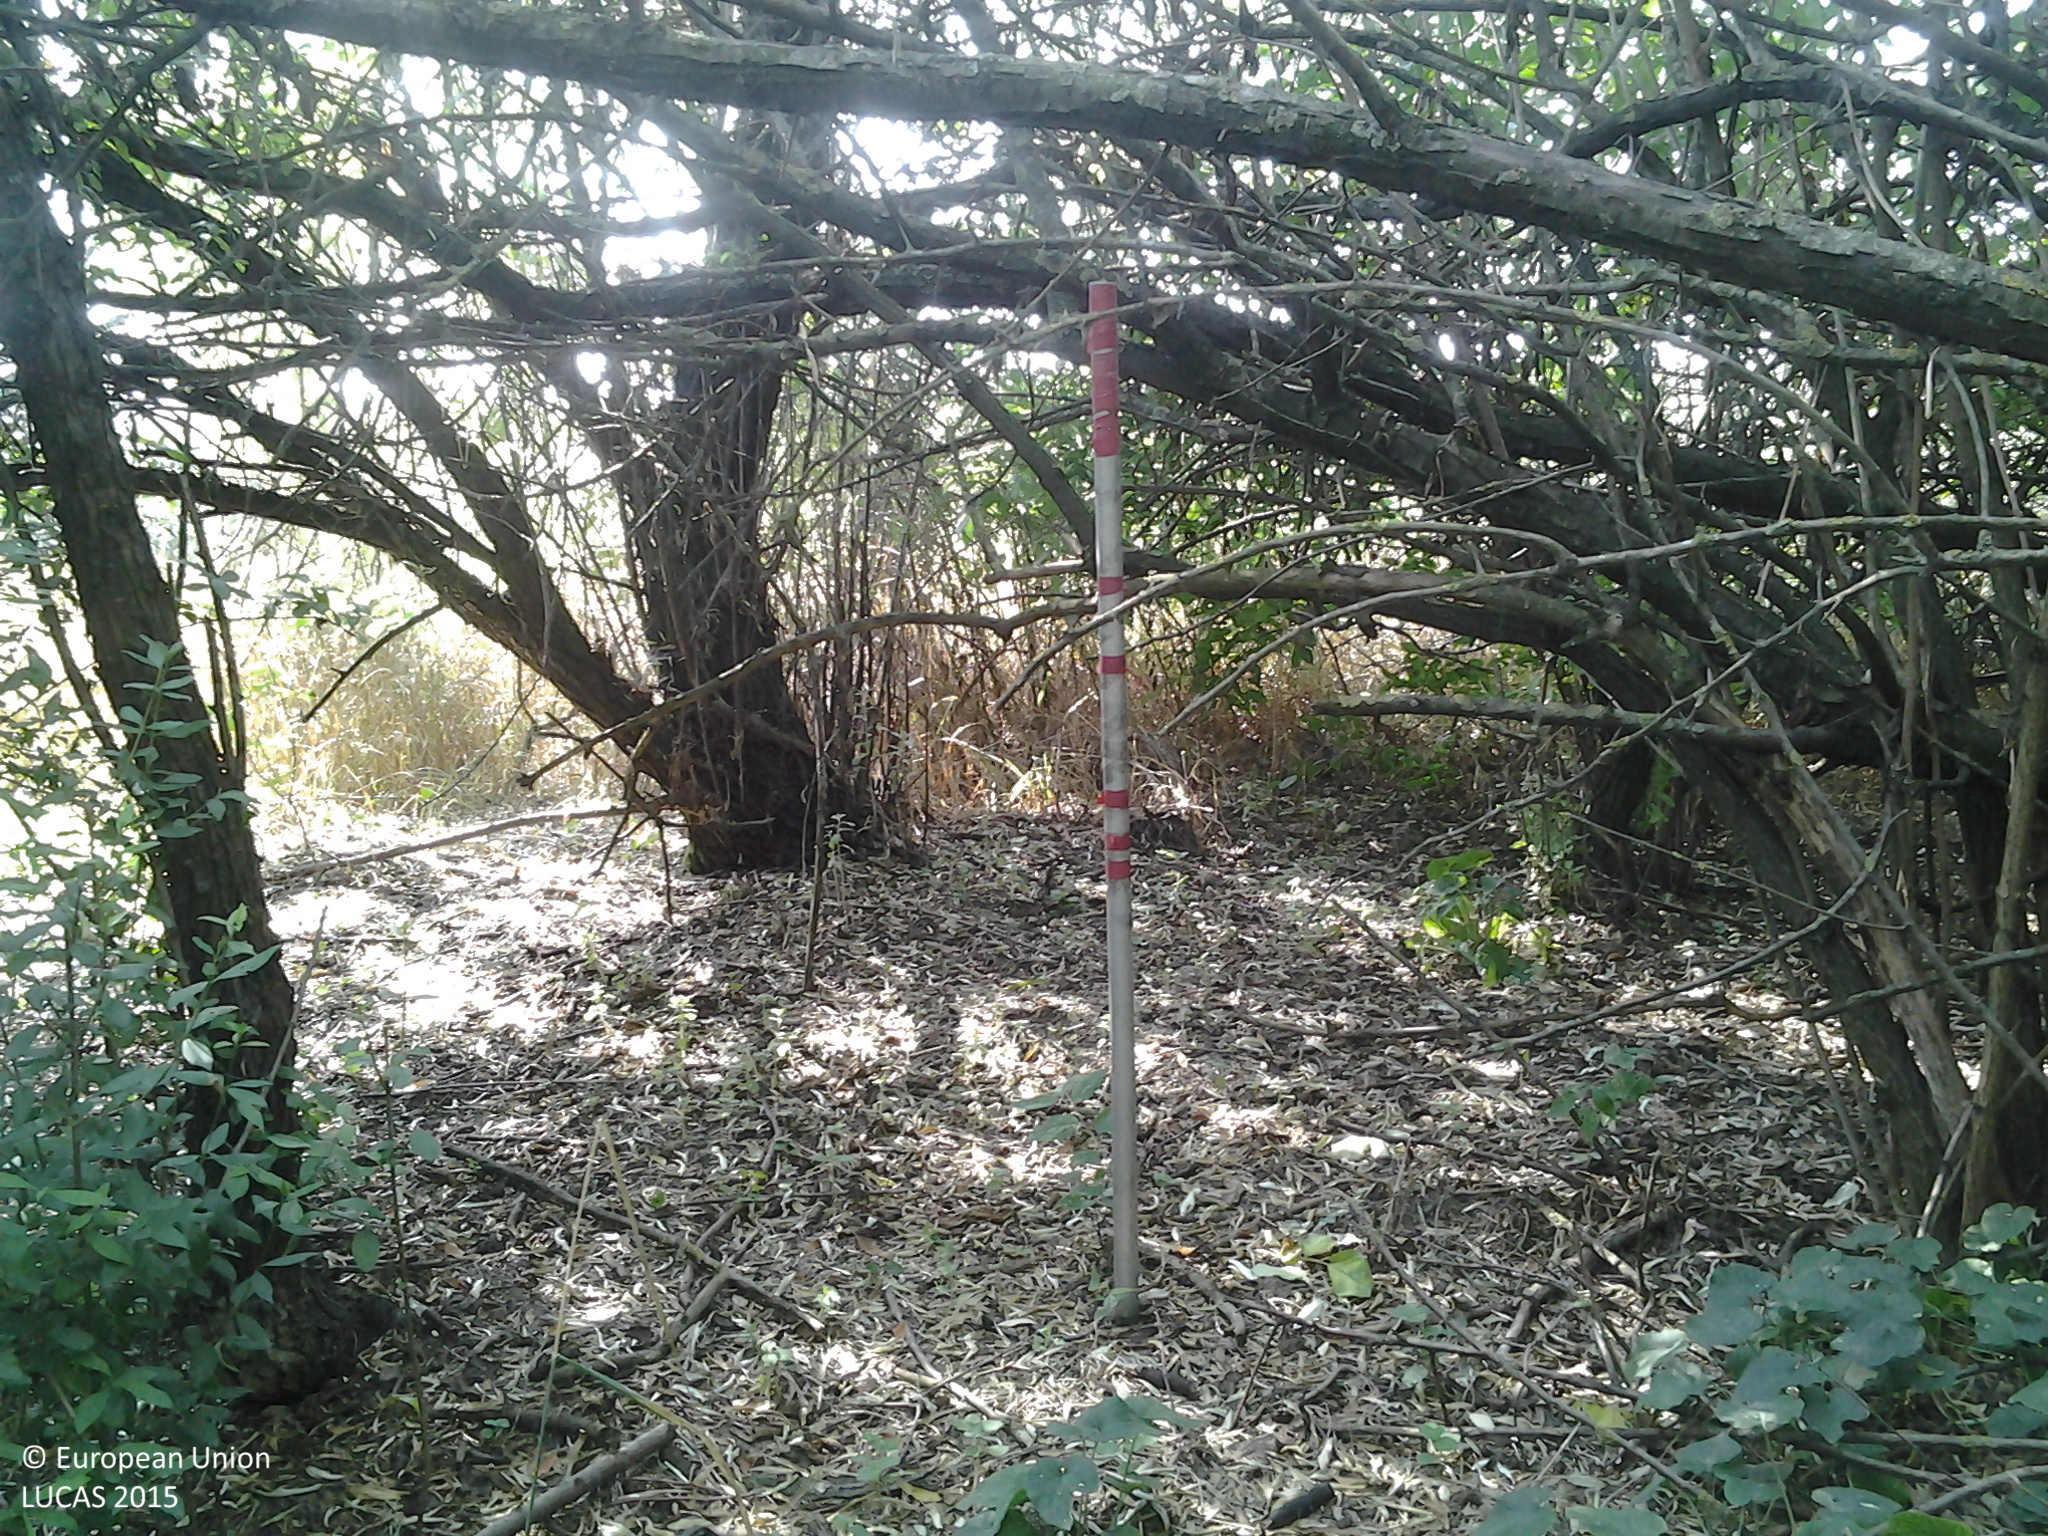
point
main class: Woodland
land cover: Broadleaved woodland
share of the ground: 50 - 75 %
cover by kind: broadleaved forest trees 60 %, herbaceous plants 40 %
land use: Semi-natural and natural areas not in use
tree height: > 5 m
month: July
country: HU
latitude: 46.8032
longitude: 19.2281
